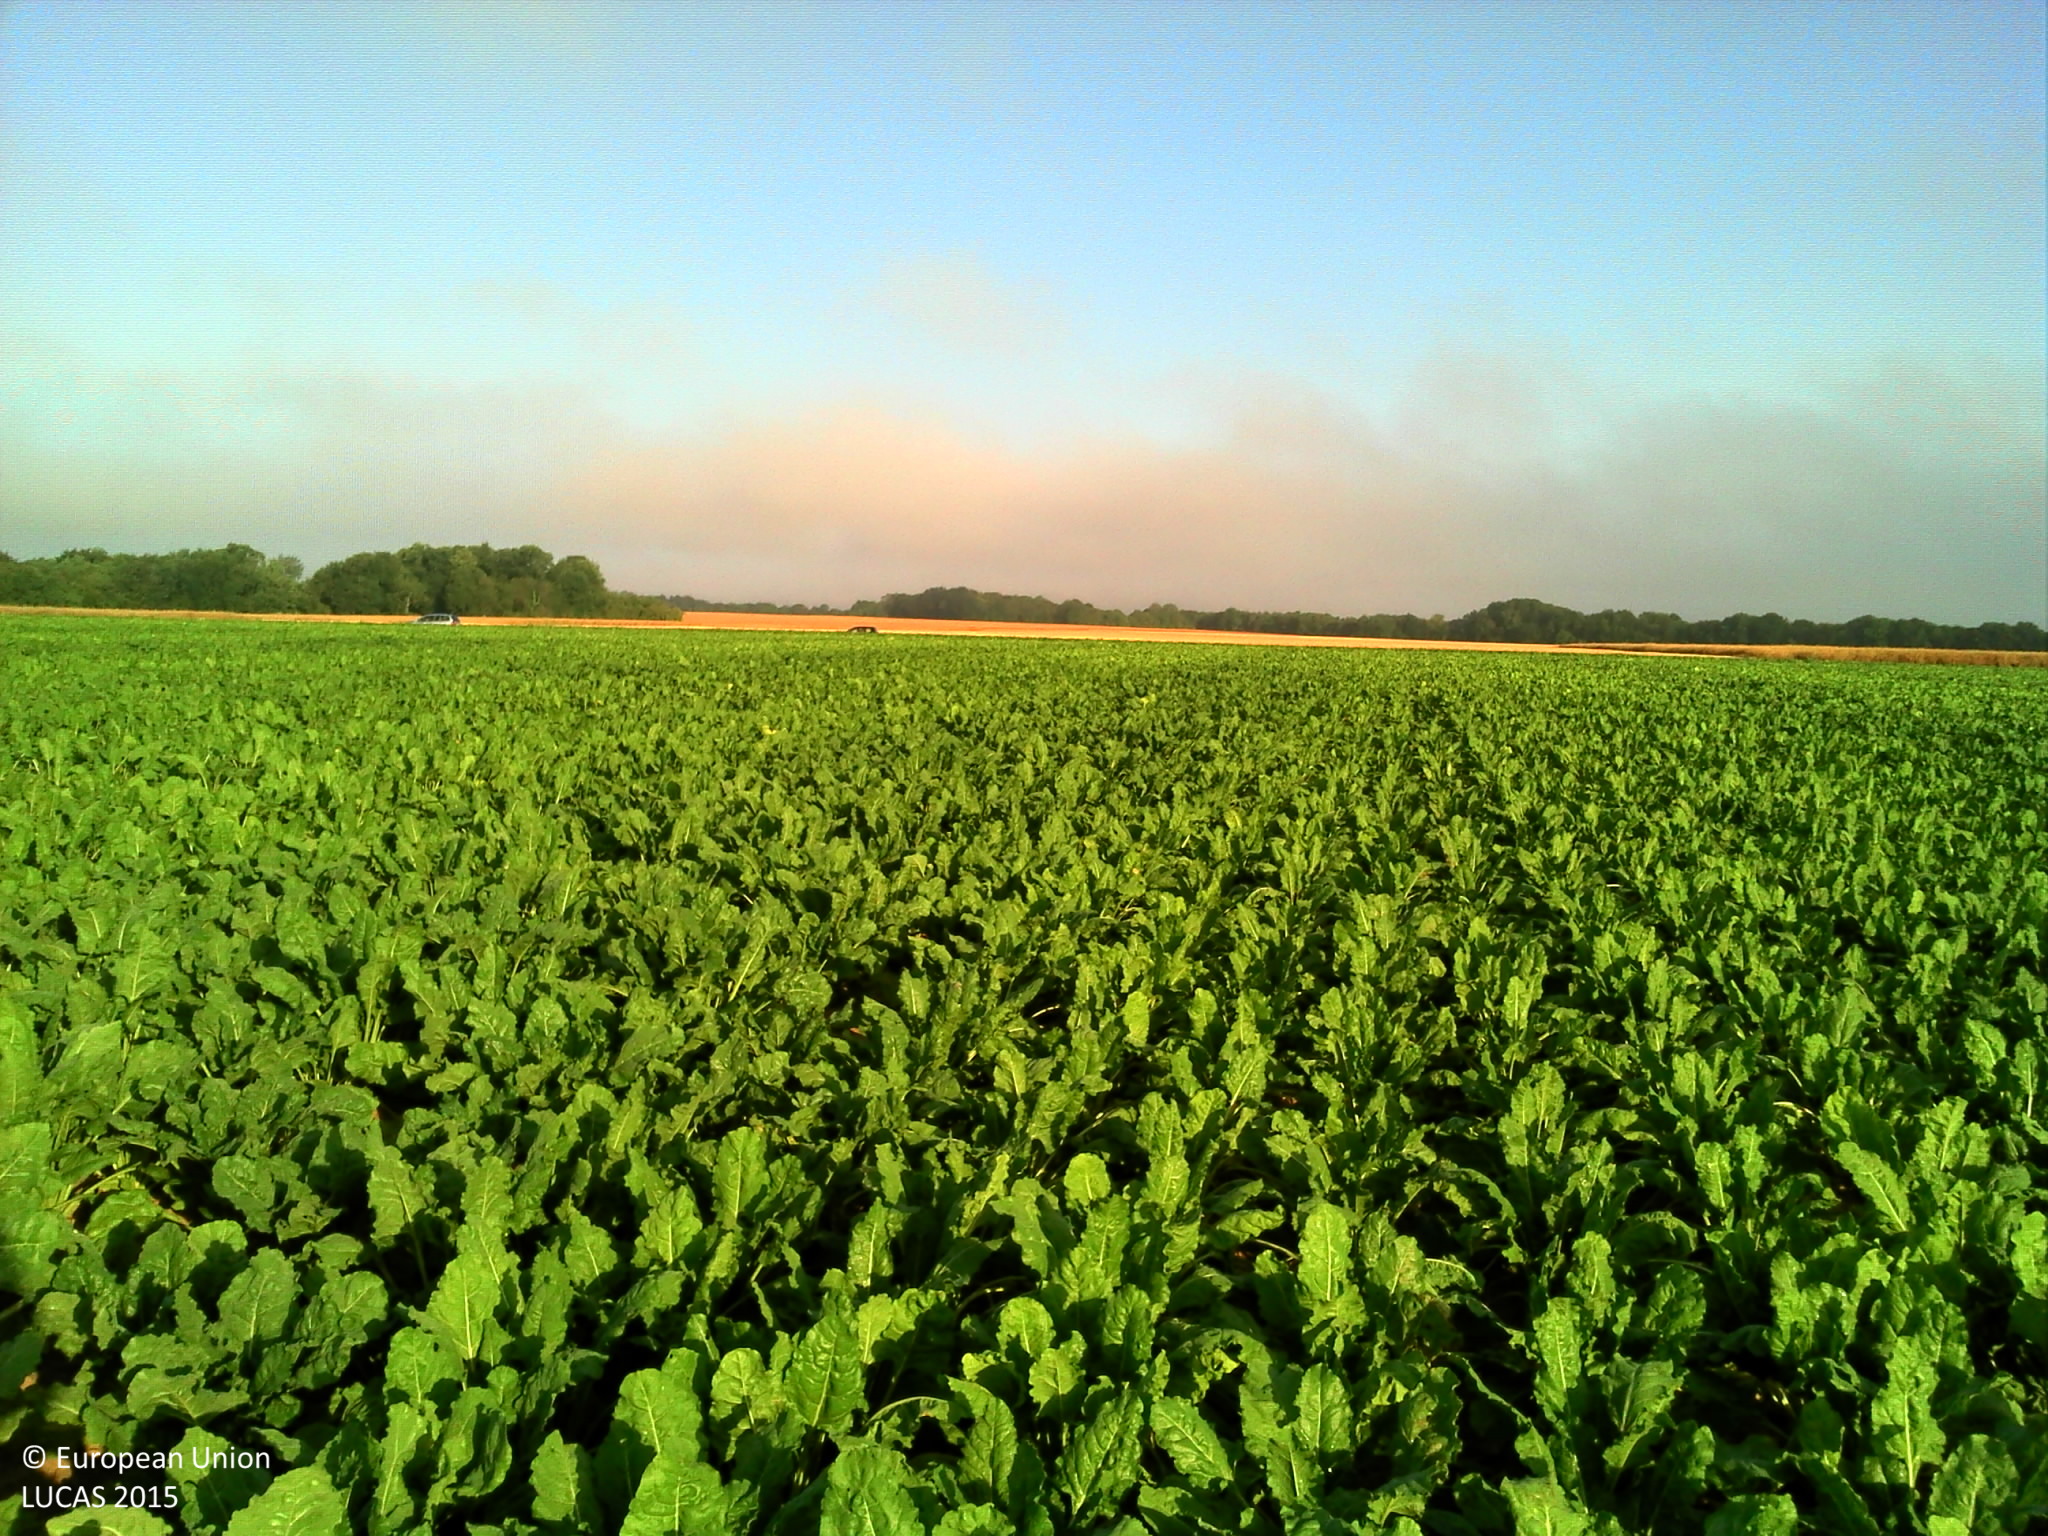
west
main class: Cropland
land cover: Sugar beet
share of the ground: > 75 %
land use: Agriculture (excluding fallow land and kitchen gardens)
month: July
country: FR
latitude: 49.3488
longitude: 2.3474
